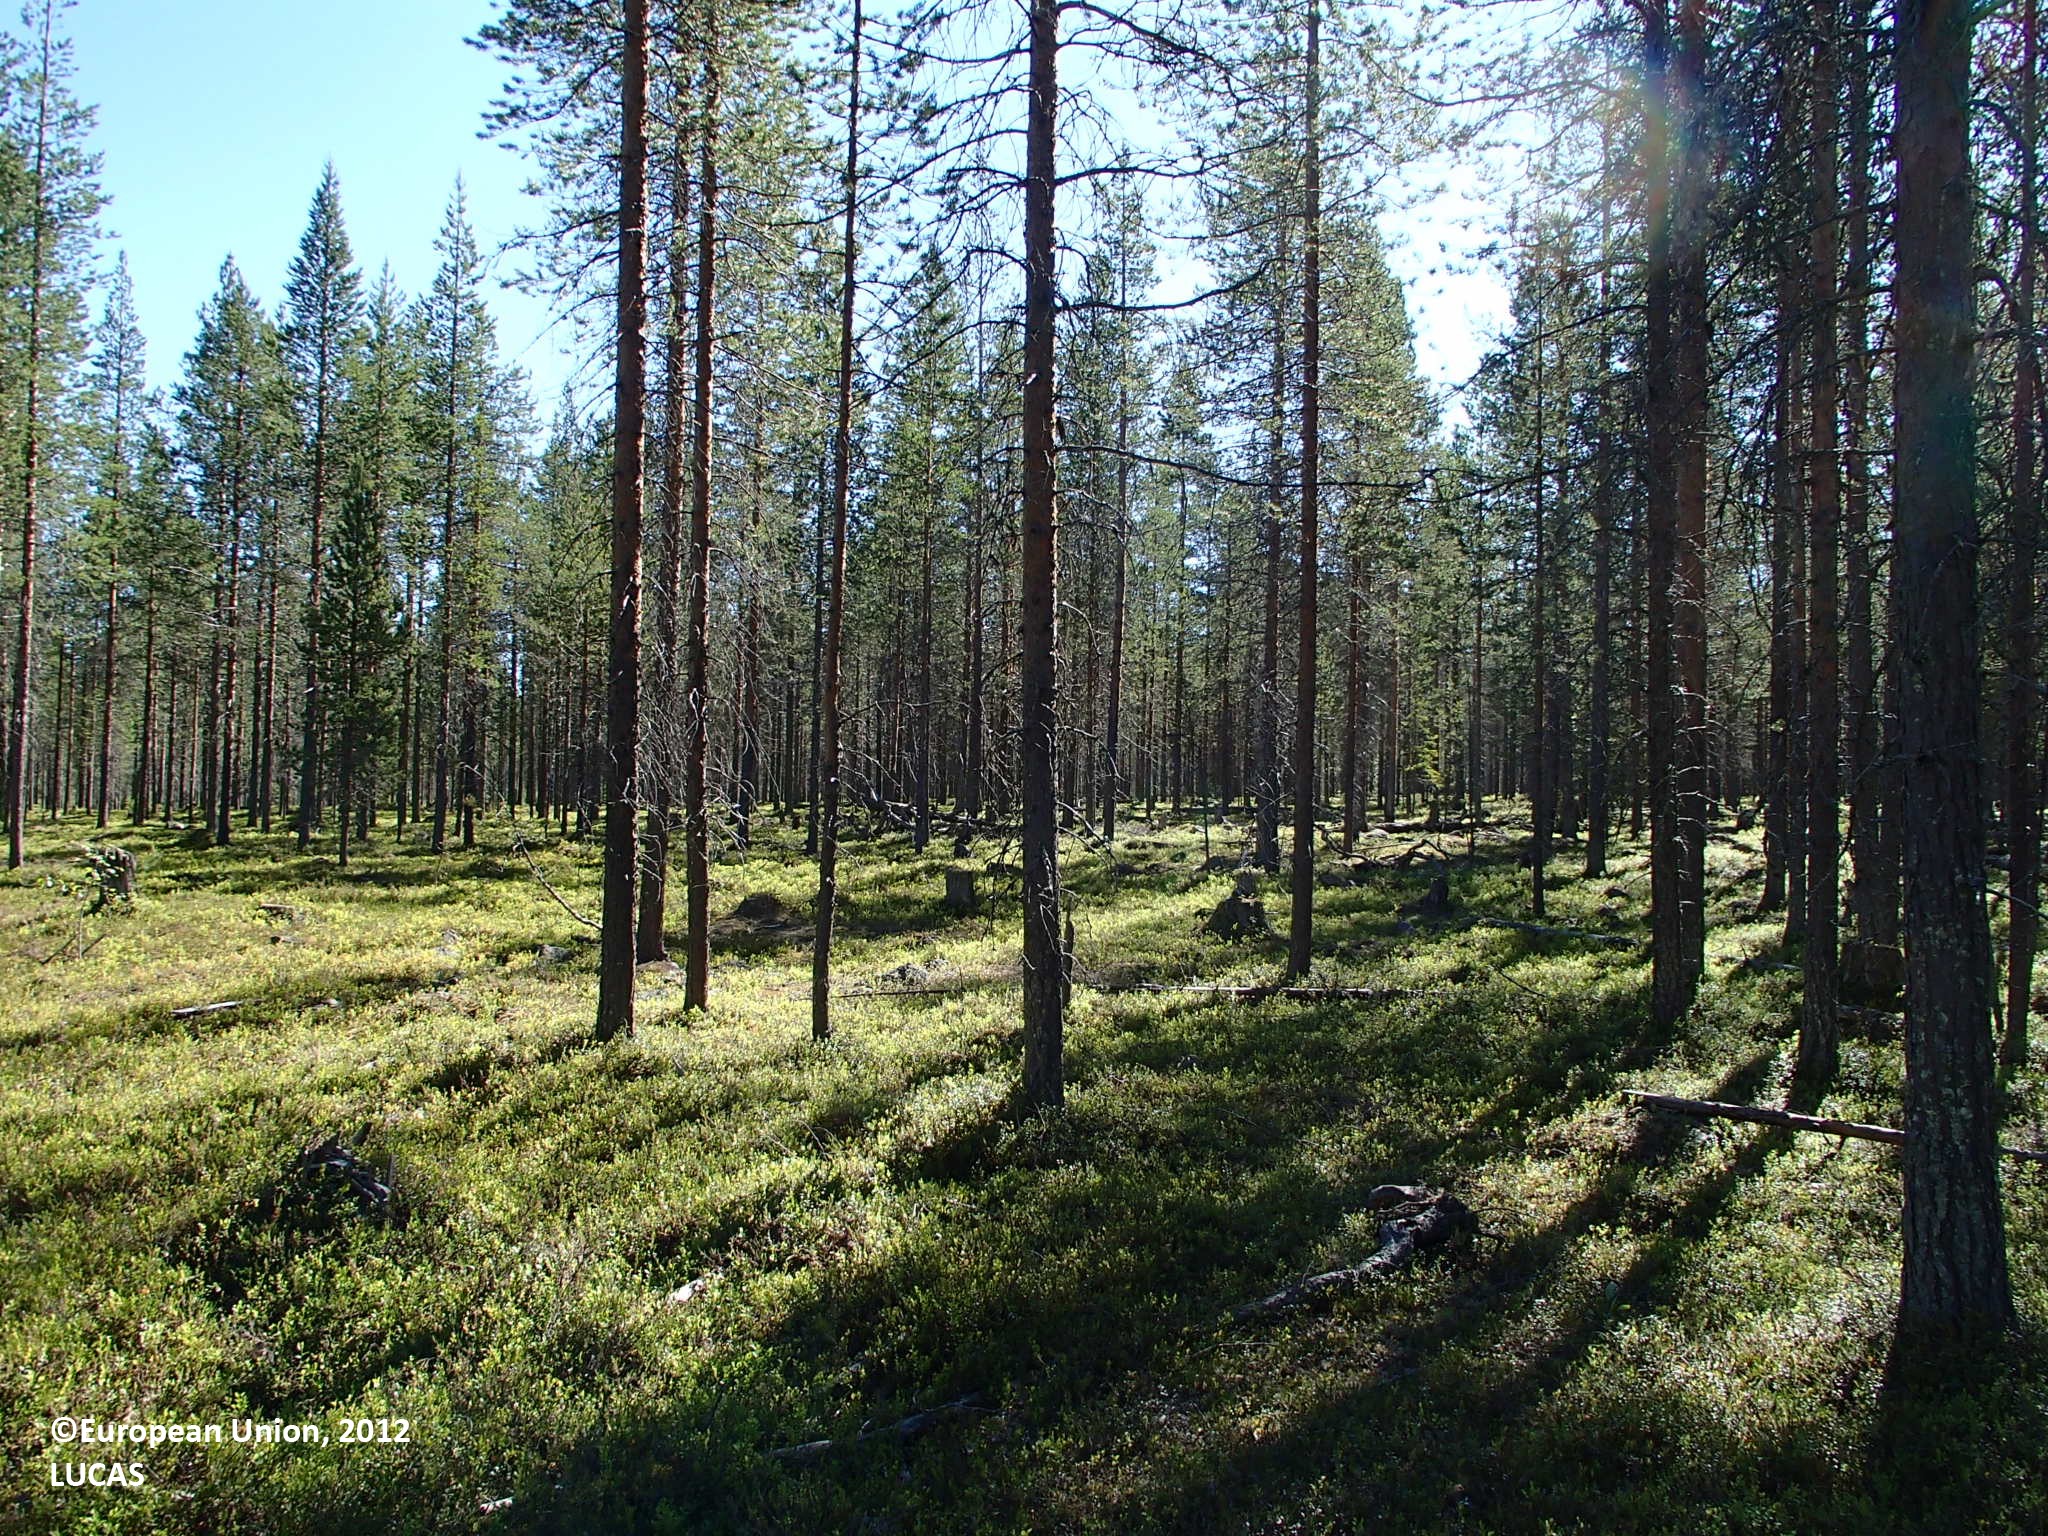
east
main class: Woodland
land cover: Pine dominated coniferous woodland
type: boreal forest
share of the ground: 25 - 50 %
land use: Forestry
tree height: > 5 m
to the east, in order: Pine dominated coniferous woodland; Other mixed woodland
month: July
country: FI
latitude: 67.2027
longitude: 26.7099
